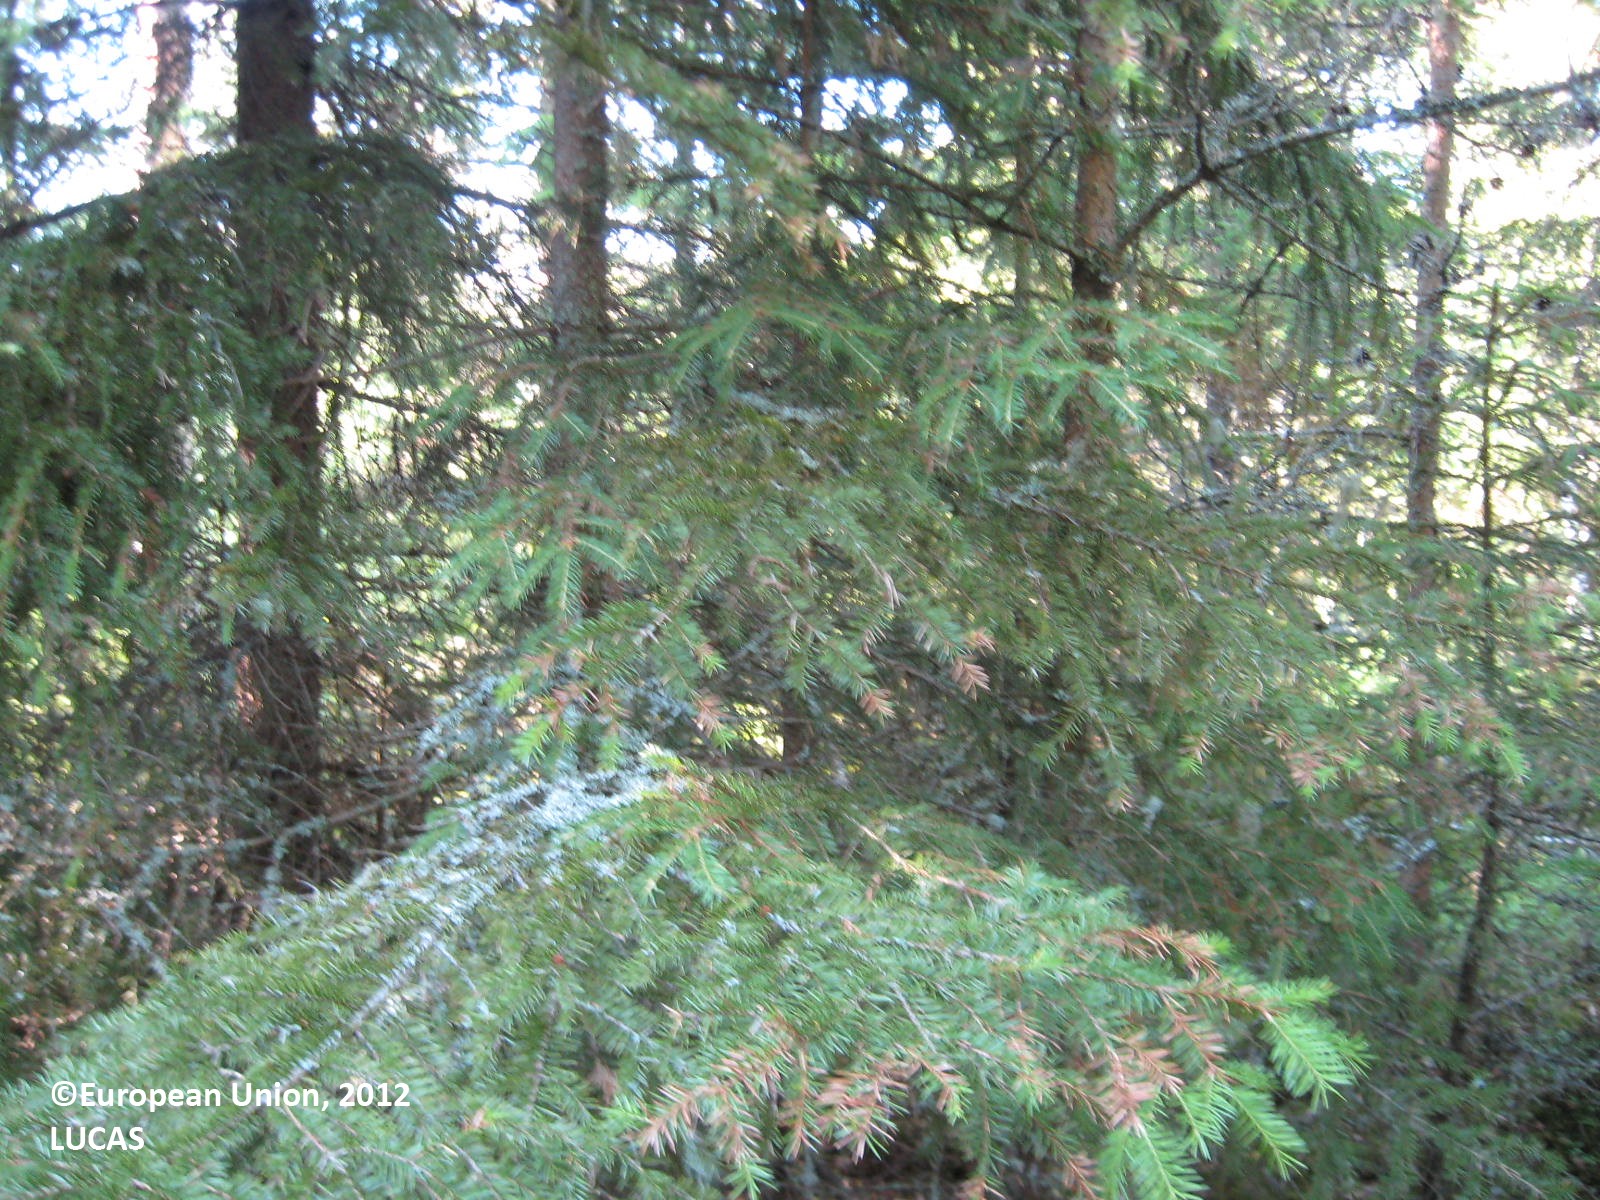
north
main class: Woodland
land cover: Spruce dominated coniferous woodland
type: boreal forest
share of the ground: > 75 %
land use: Forestry
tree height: > 5 m
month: July
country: FI
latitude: 62.1696
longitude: 21.5086
